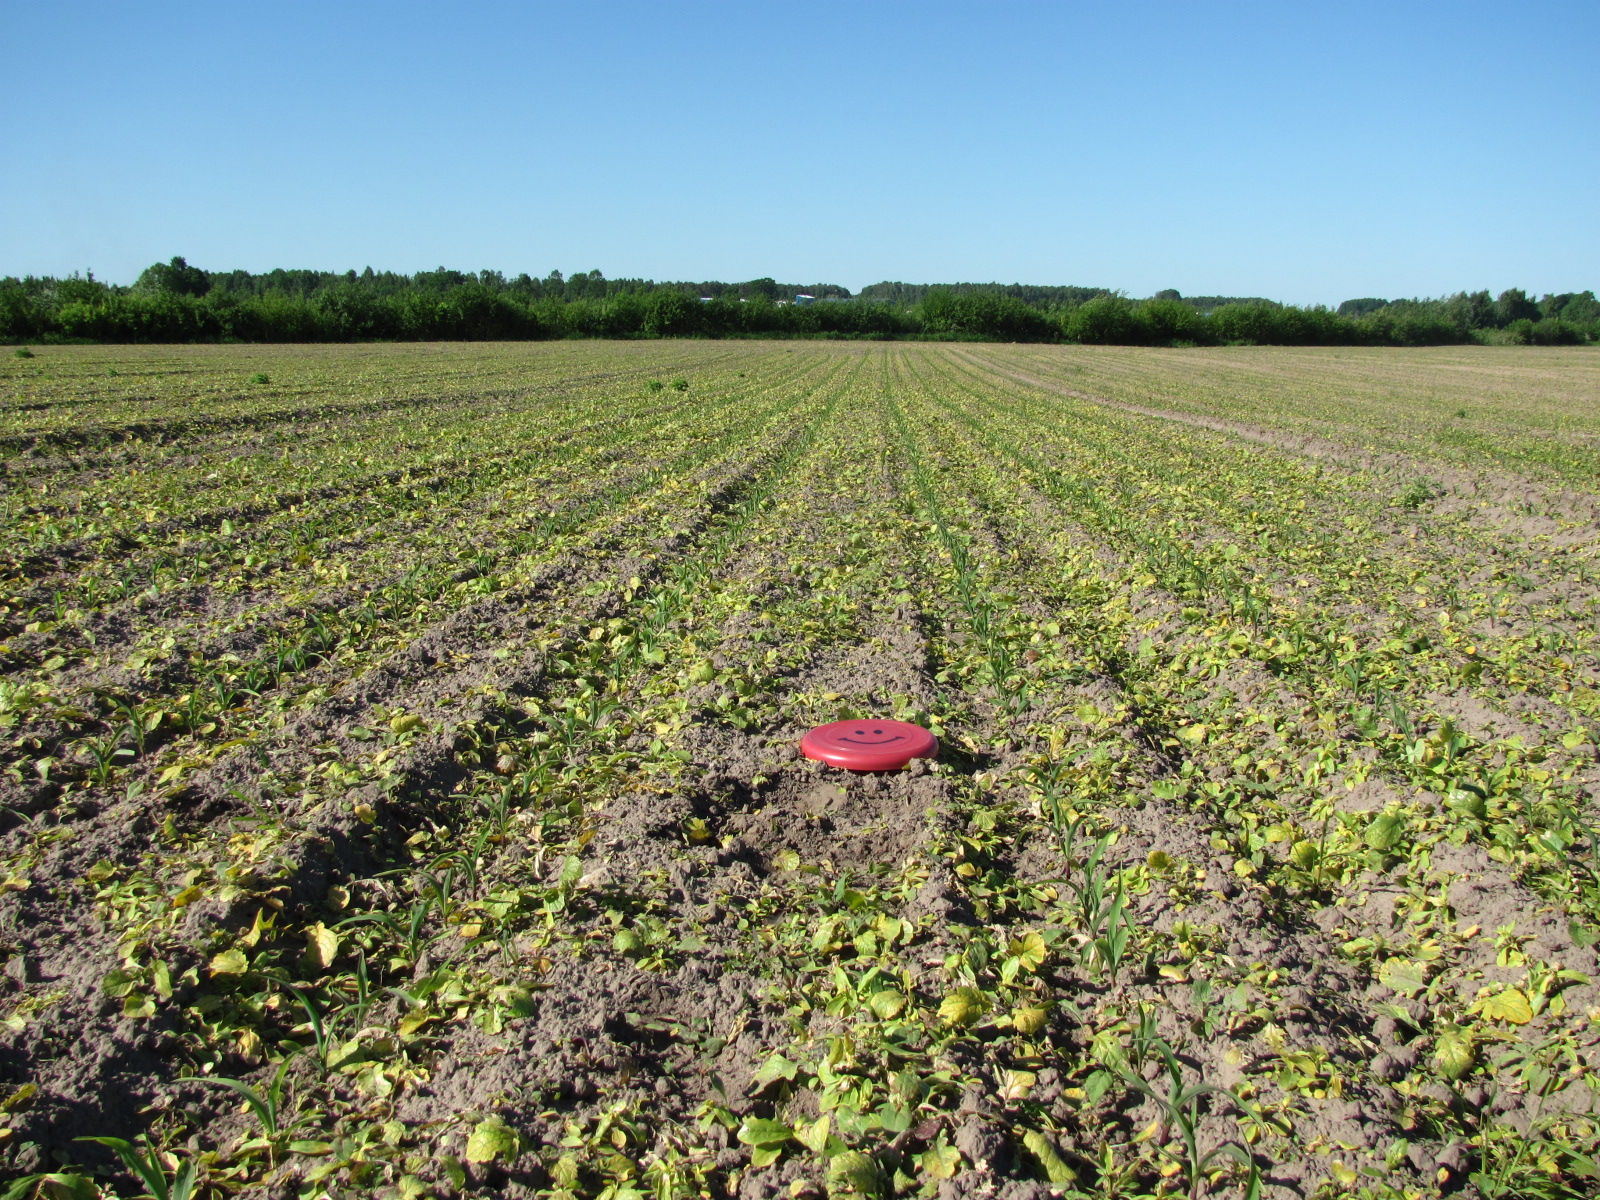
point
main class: Cropland
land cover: Maize
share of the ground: < 10 %
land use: Agriculture (excluding fallow land and kitchen gardens)
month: June
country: LV
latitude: 56.5213
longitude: 24.2479
